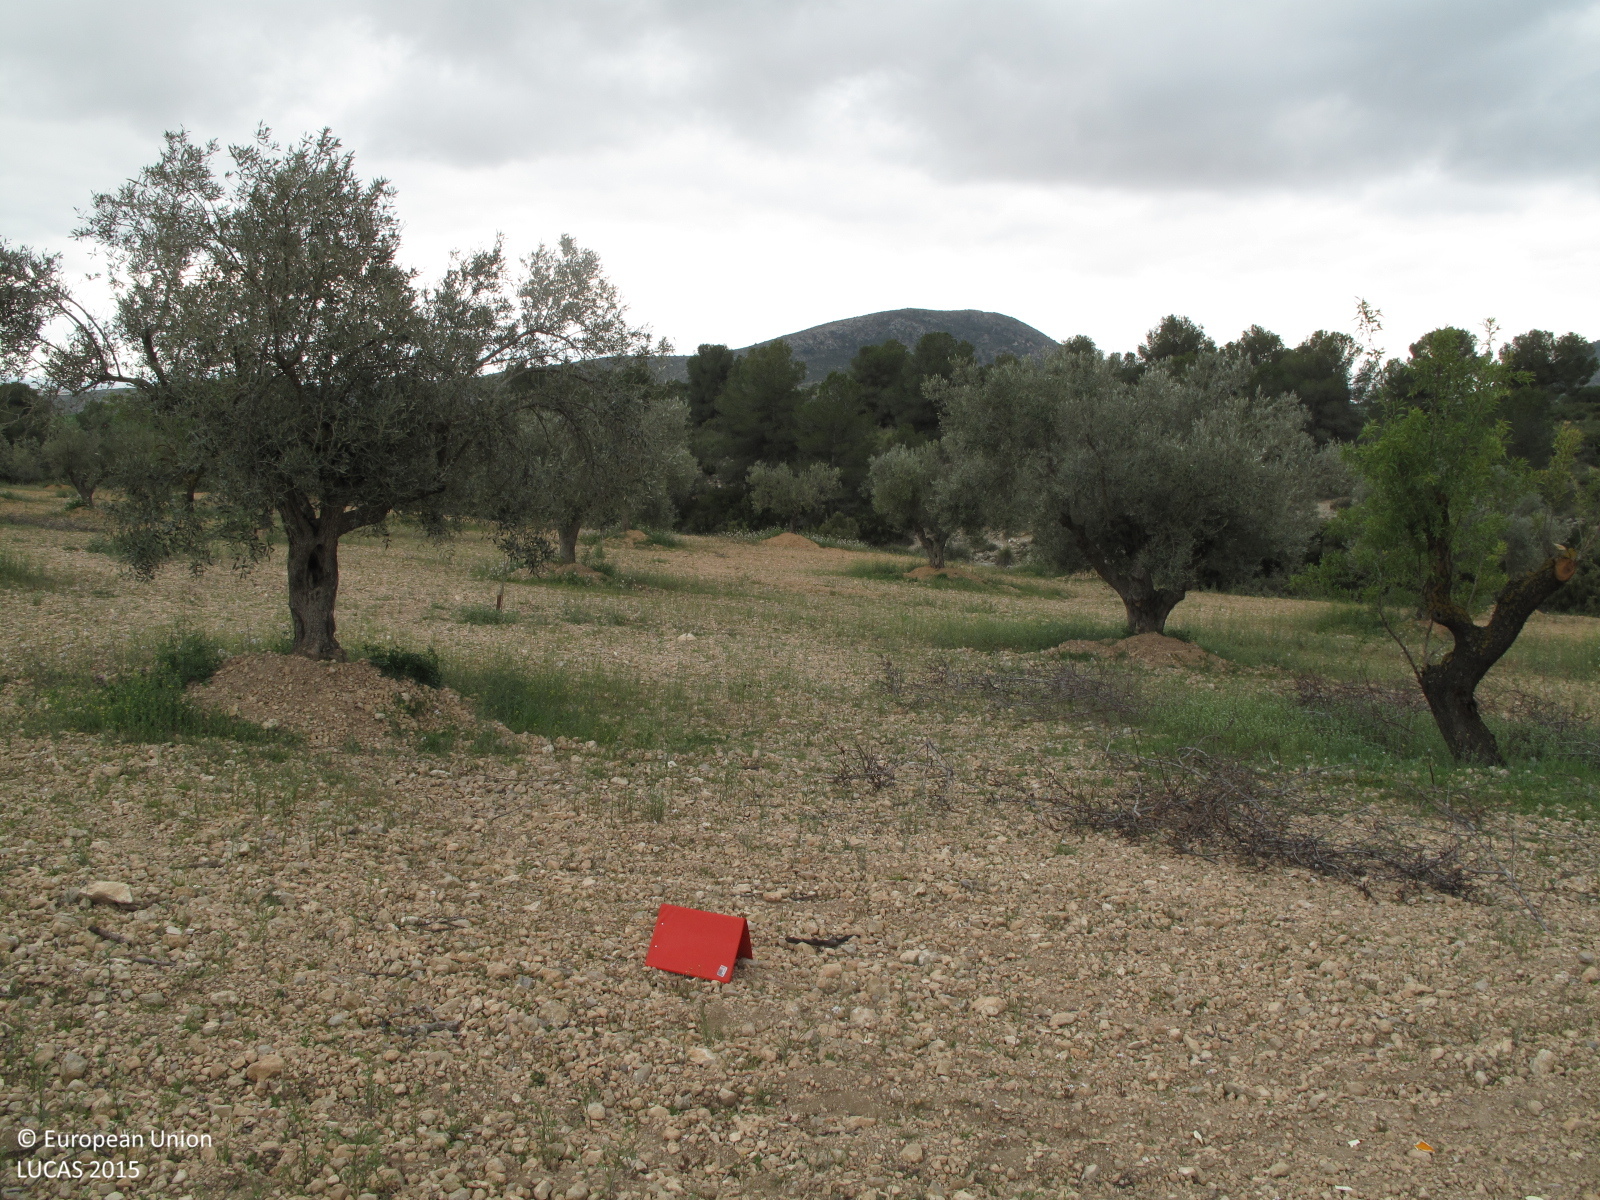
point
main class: Cropland
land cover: Olive groves
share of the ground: 25 - 50 %
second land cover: Nuts trees
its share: 25 - 50 %
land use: Agriculture (excluding fallow land and kitchen gardens)
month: April
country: ES
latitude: 38.7724
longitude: -0.9844
